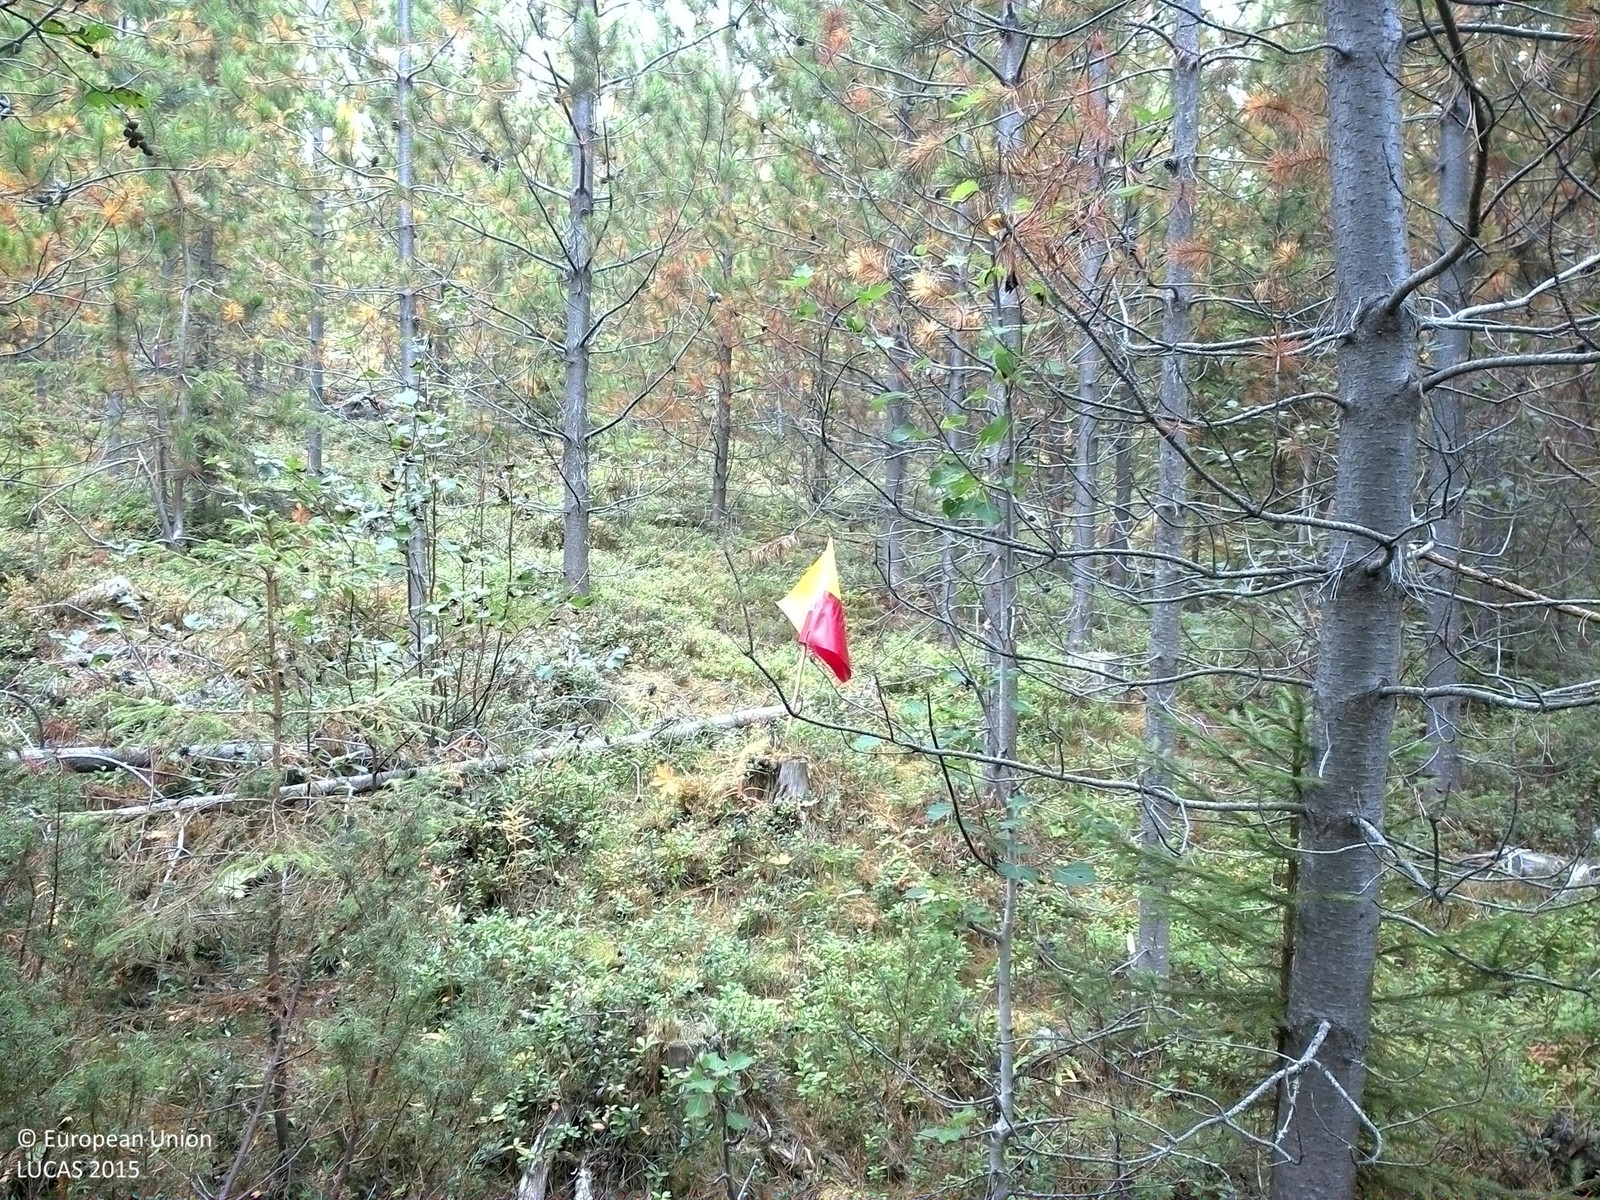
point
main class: Woodland
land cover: Pine dominated coniferous woodland
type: exotic forest
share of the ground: 50 - 75 %
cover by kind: coniferous forest trees 40 %, shrubs 40 %, broadleaved forest trees 10 %, lichens and mosses 10 %
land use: Forestry
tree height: > 5 m
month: September
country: SE
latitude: 63.8286
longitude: 16.5357
